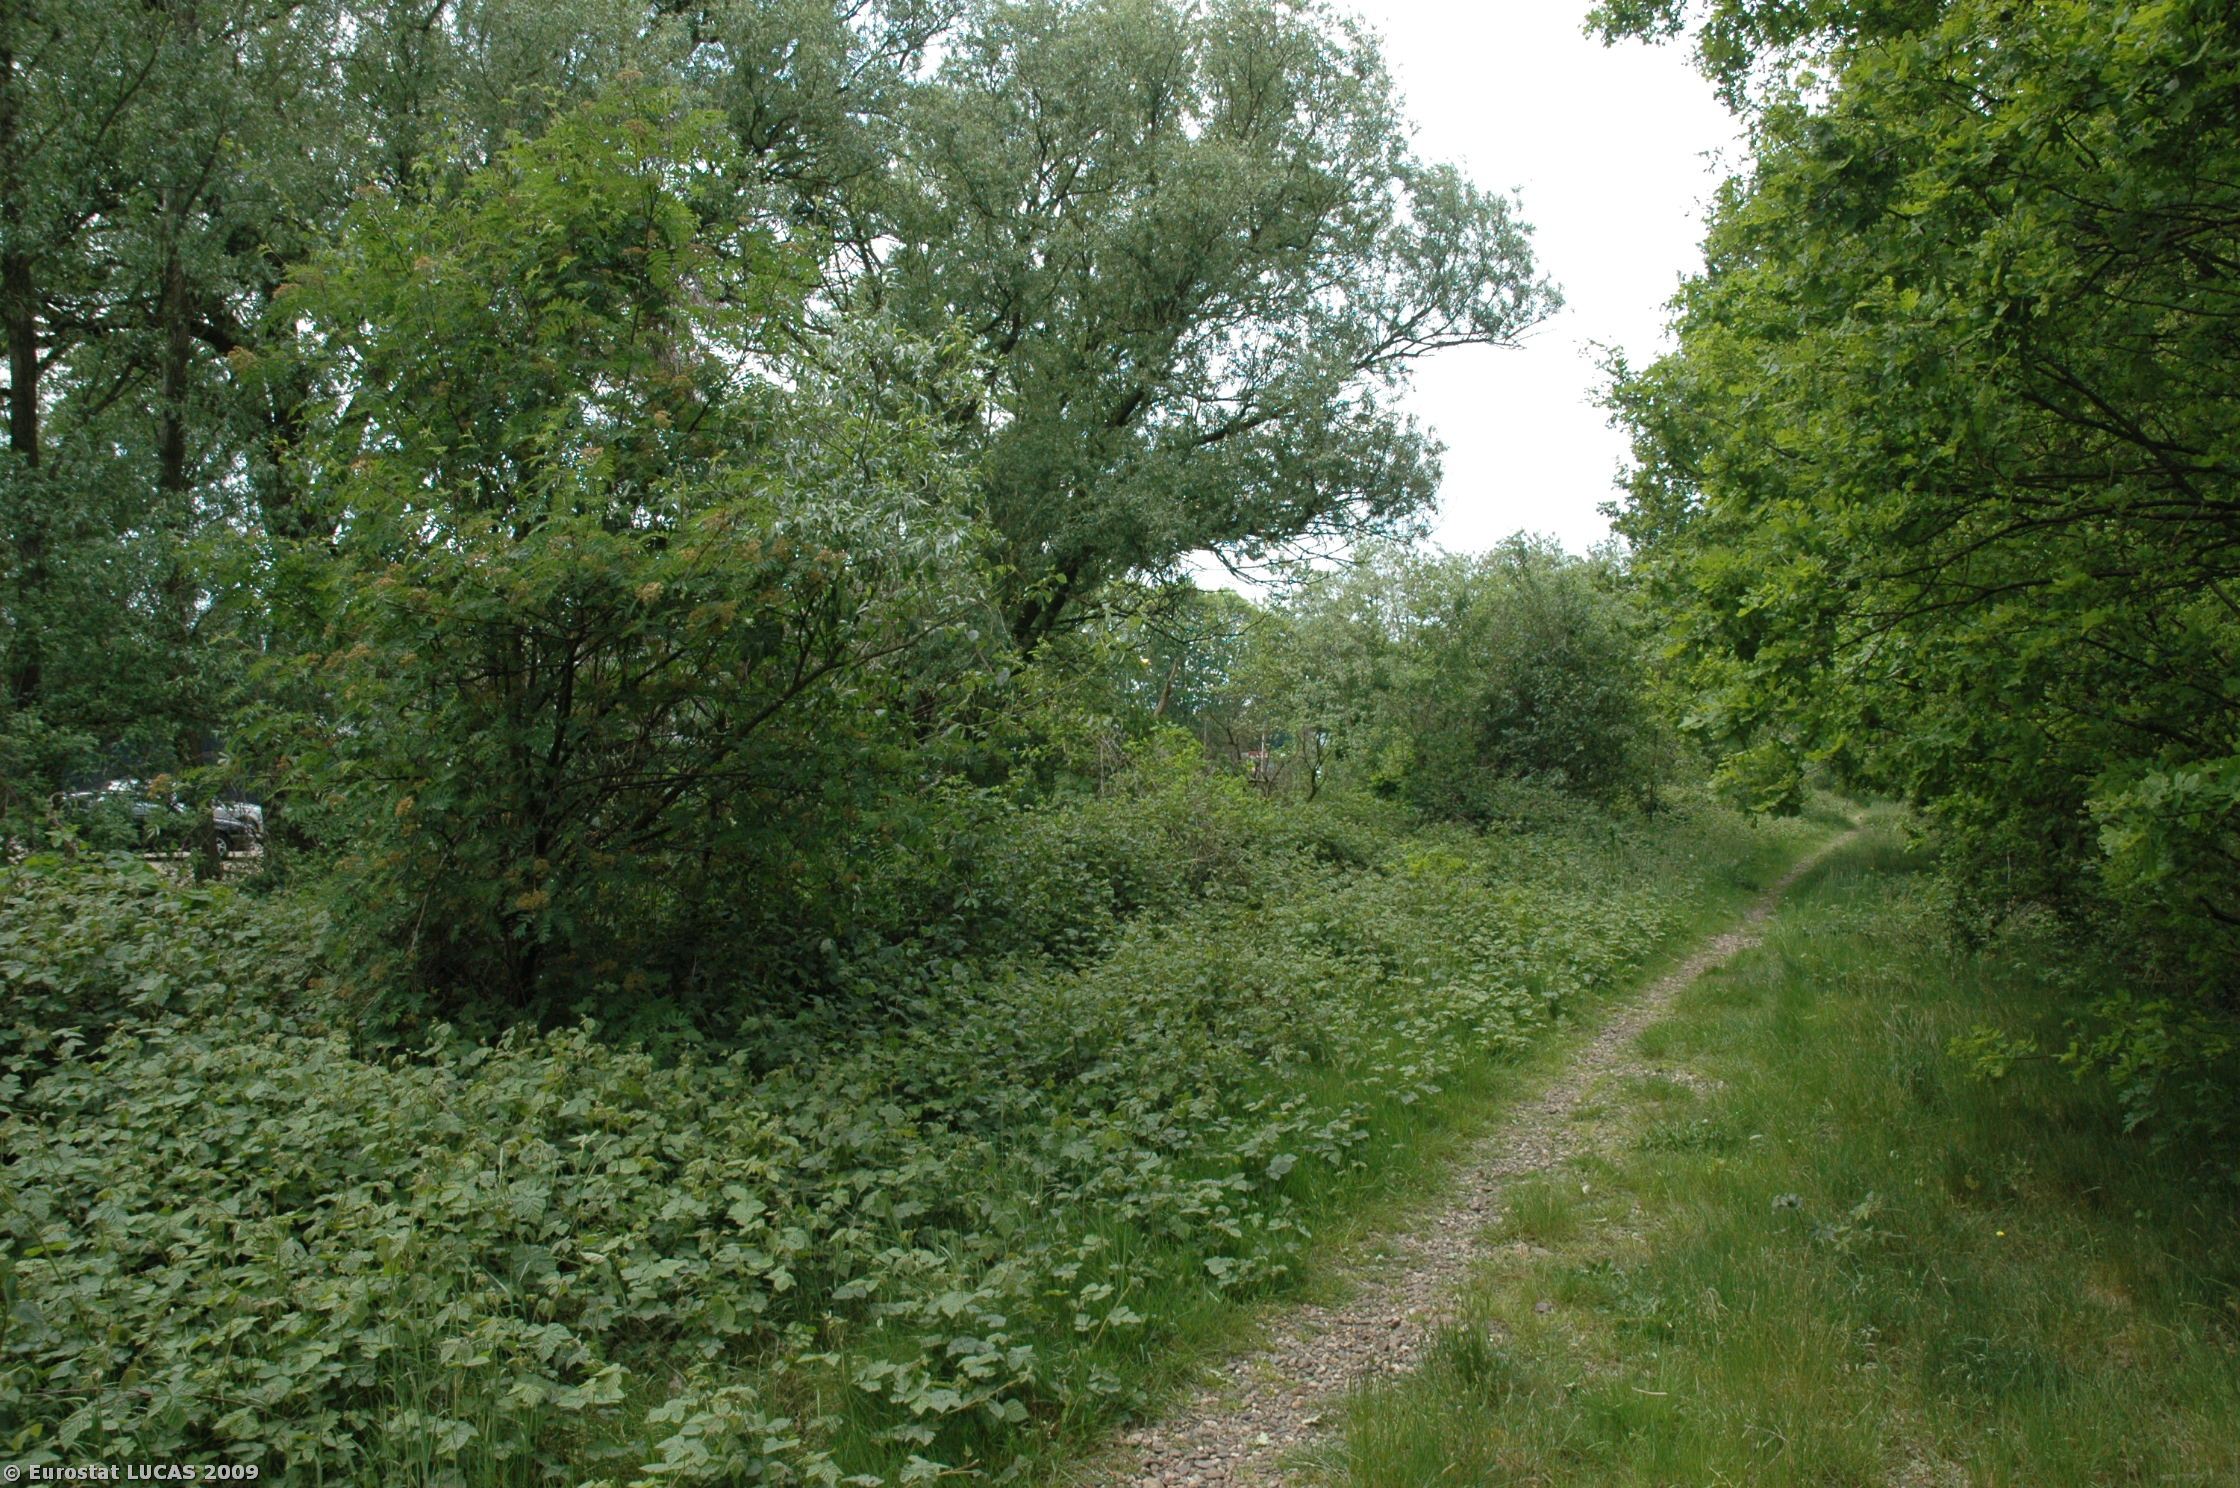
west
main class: Grassland
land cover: Grassland without tree/shrub cover
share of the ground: > 75 %
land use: Agriculture (excluding fallow land and kitchen gardens)
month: May
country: NL
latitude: 52.1094
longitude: 5.4279
